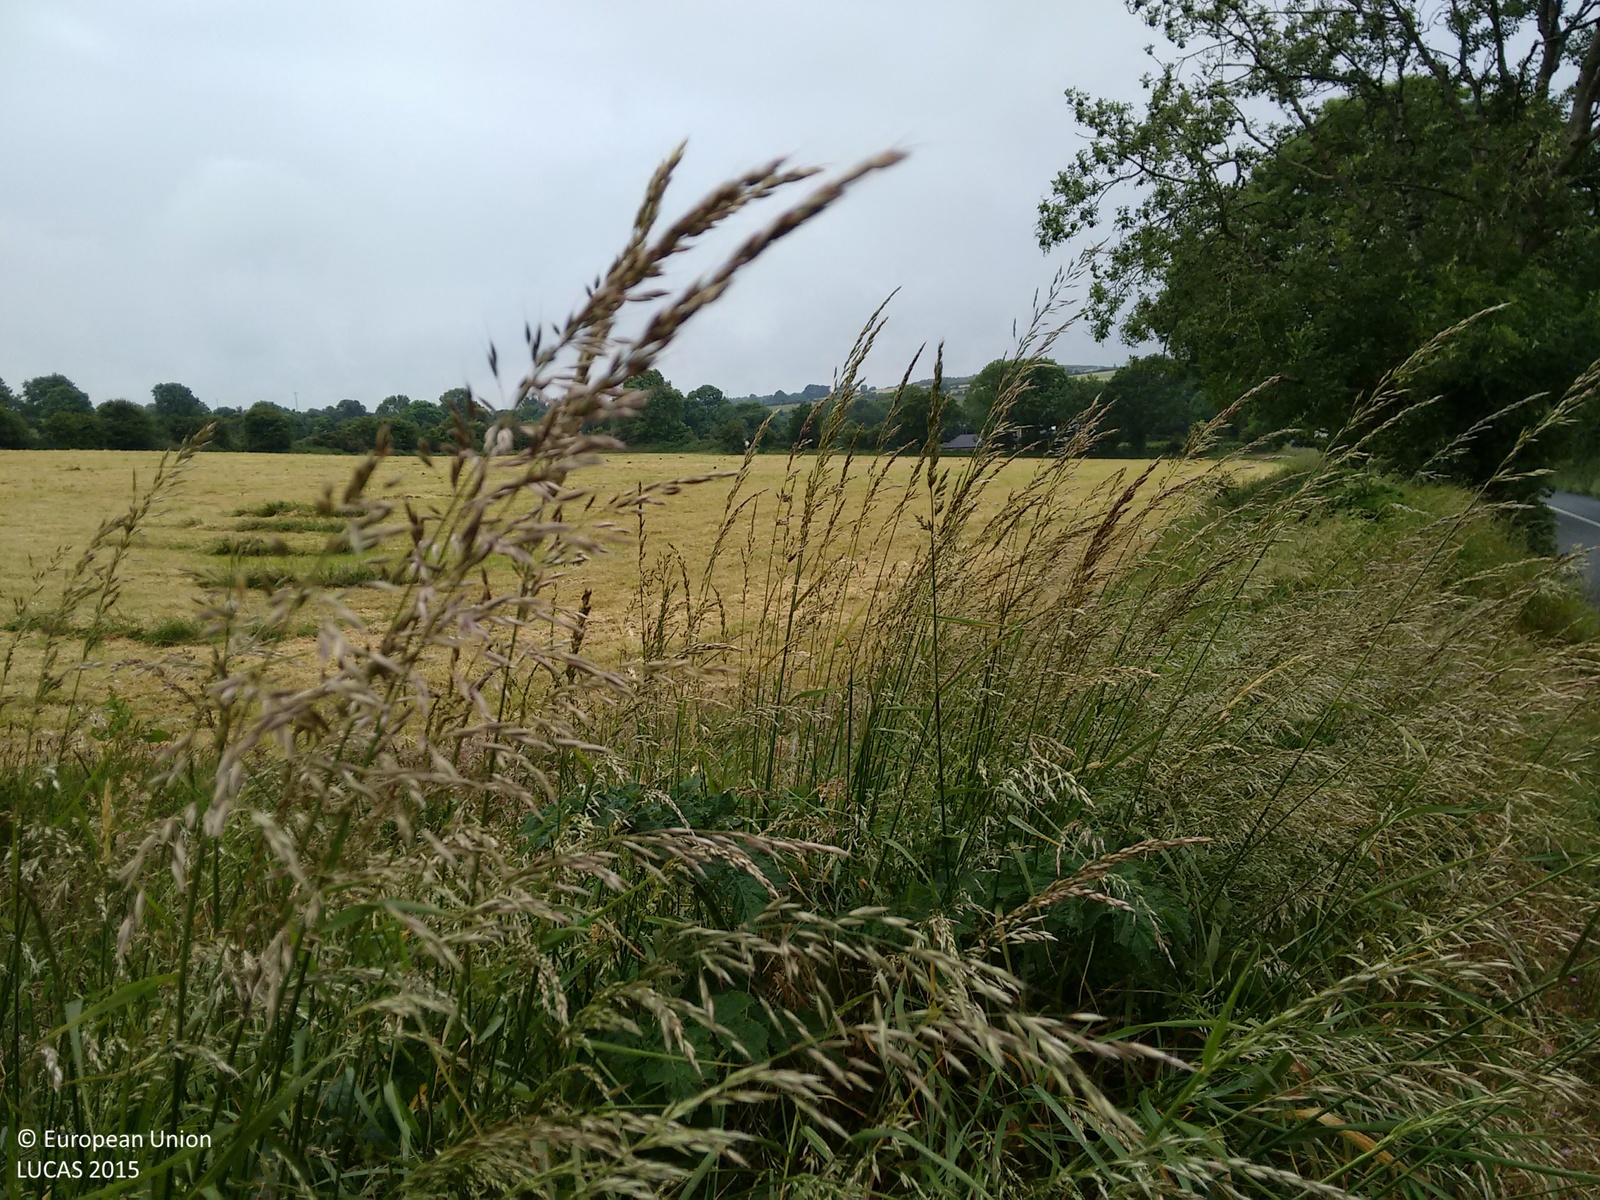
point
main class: Grassland
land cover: Grassland without tree/shrub cover
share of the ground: > 75 %
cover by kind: herbaceous plants 100 %
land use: Agriculture (excluding fallow land and kitchen gardens)
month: June
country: IE
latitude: 52.2258
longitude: -7.2350
